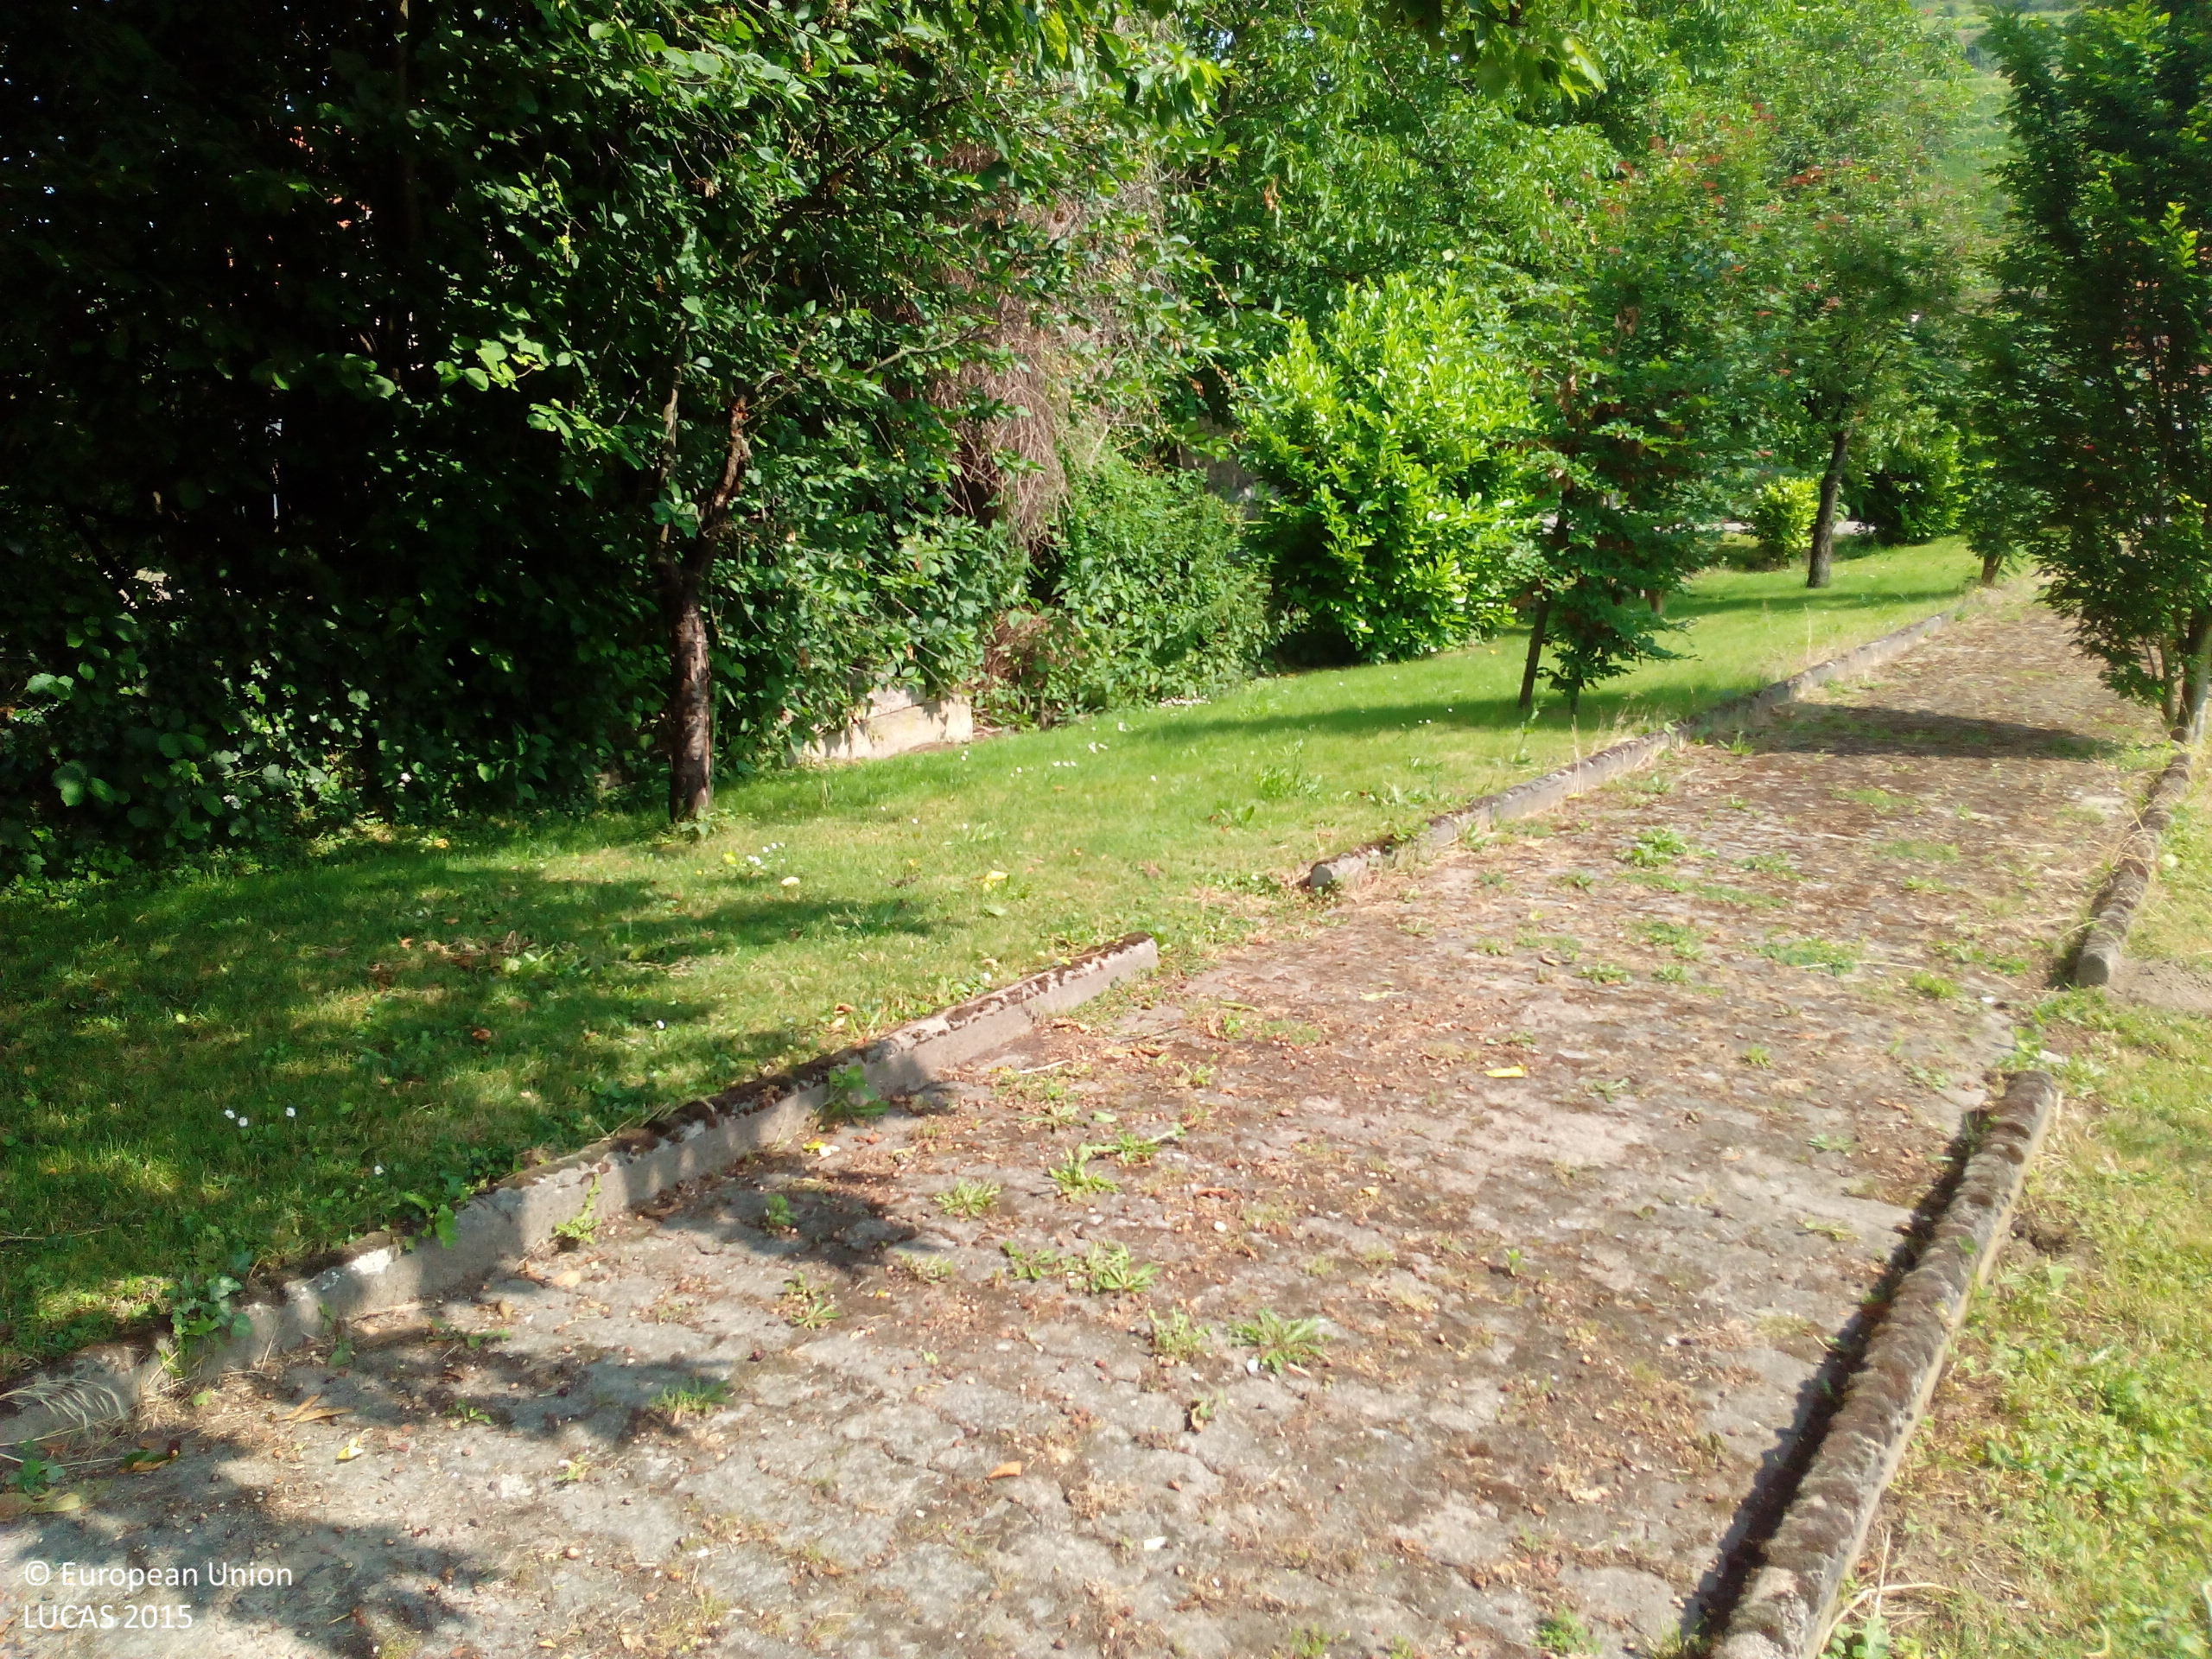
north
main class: Woodland
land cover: Broadleaved woodland
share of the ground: > 75 %
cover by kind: herbaceous plants 65 %, broadleaved forest trees 15 %, shrubs 10 %, consolidated bare surface 10 %
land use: Residential
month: June
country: DE
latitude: 48.1271
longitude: 7.6768
